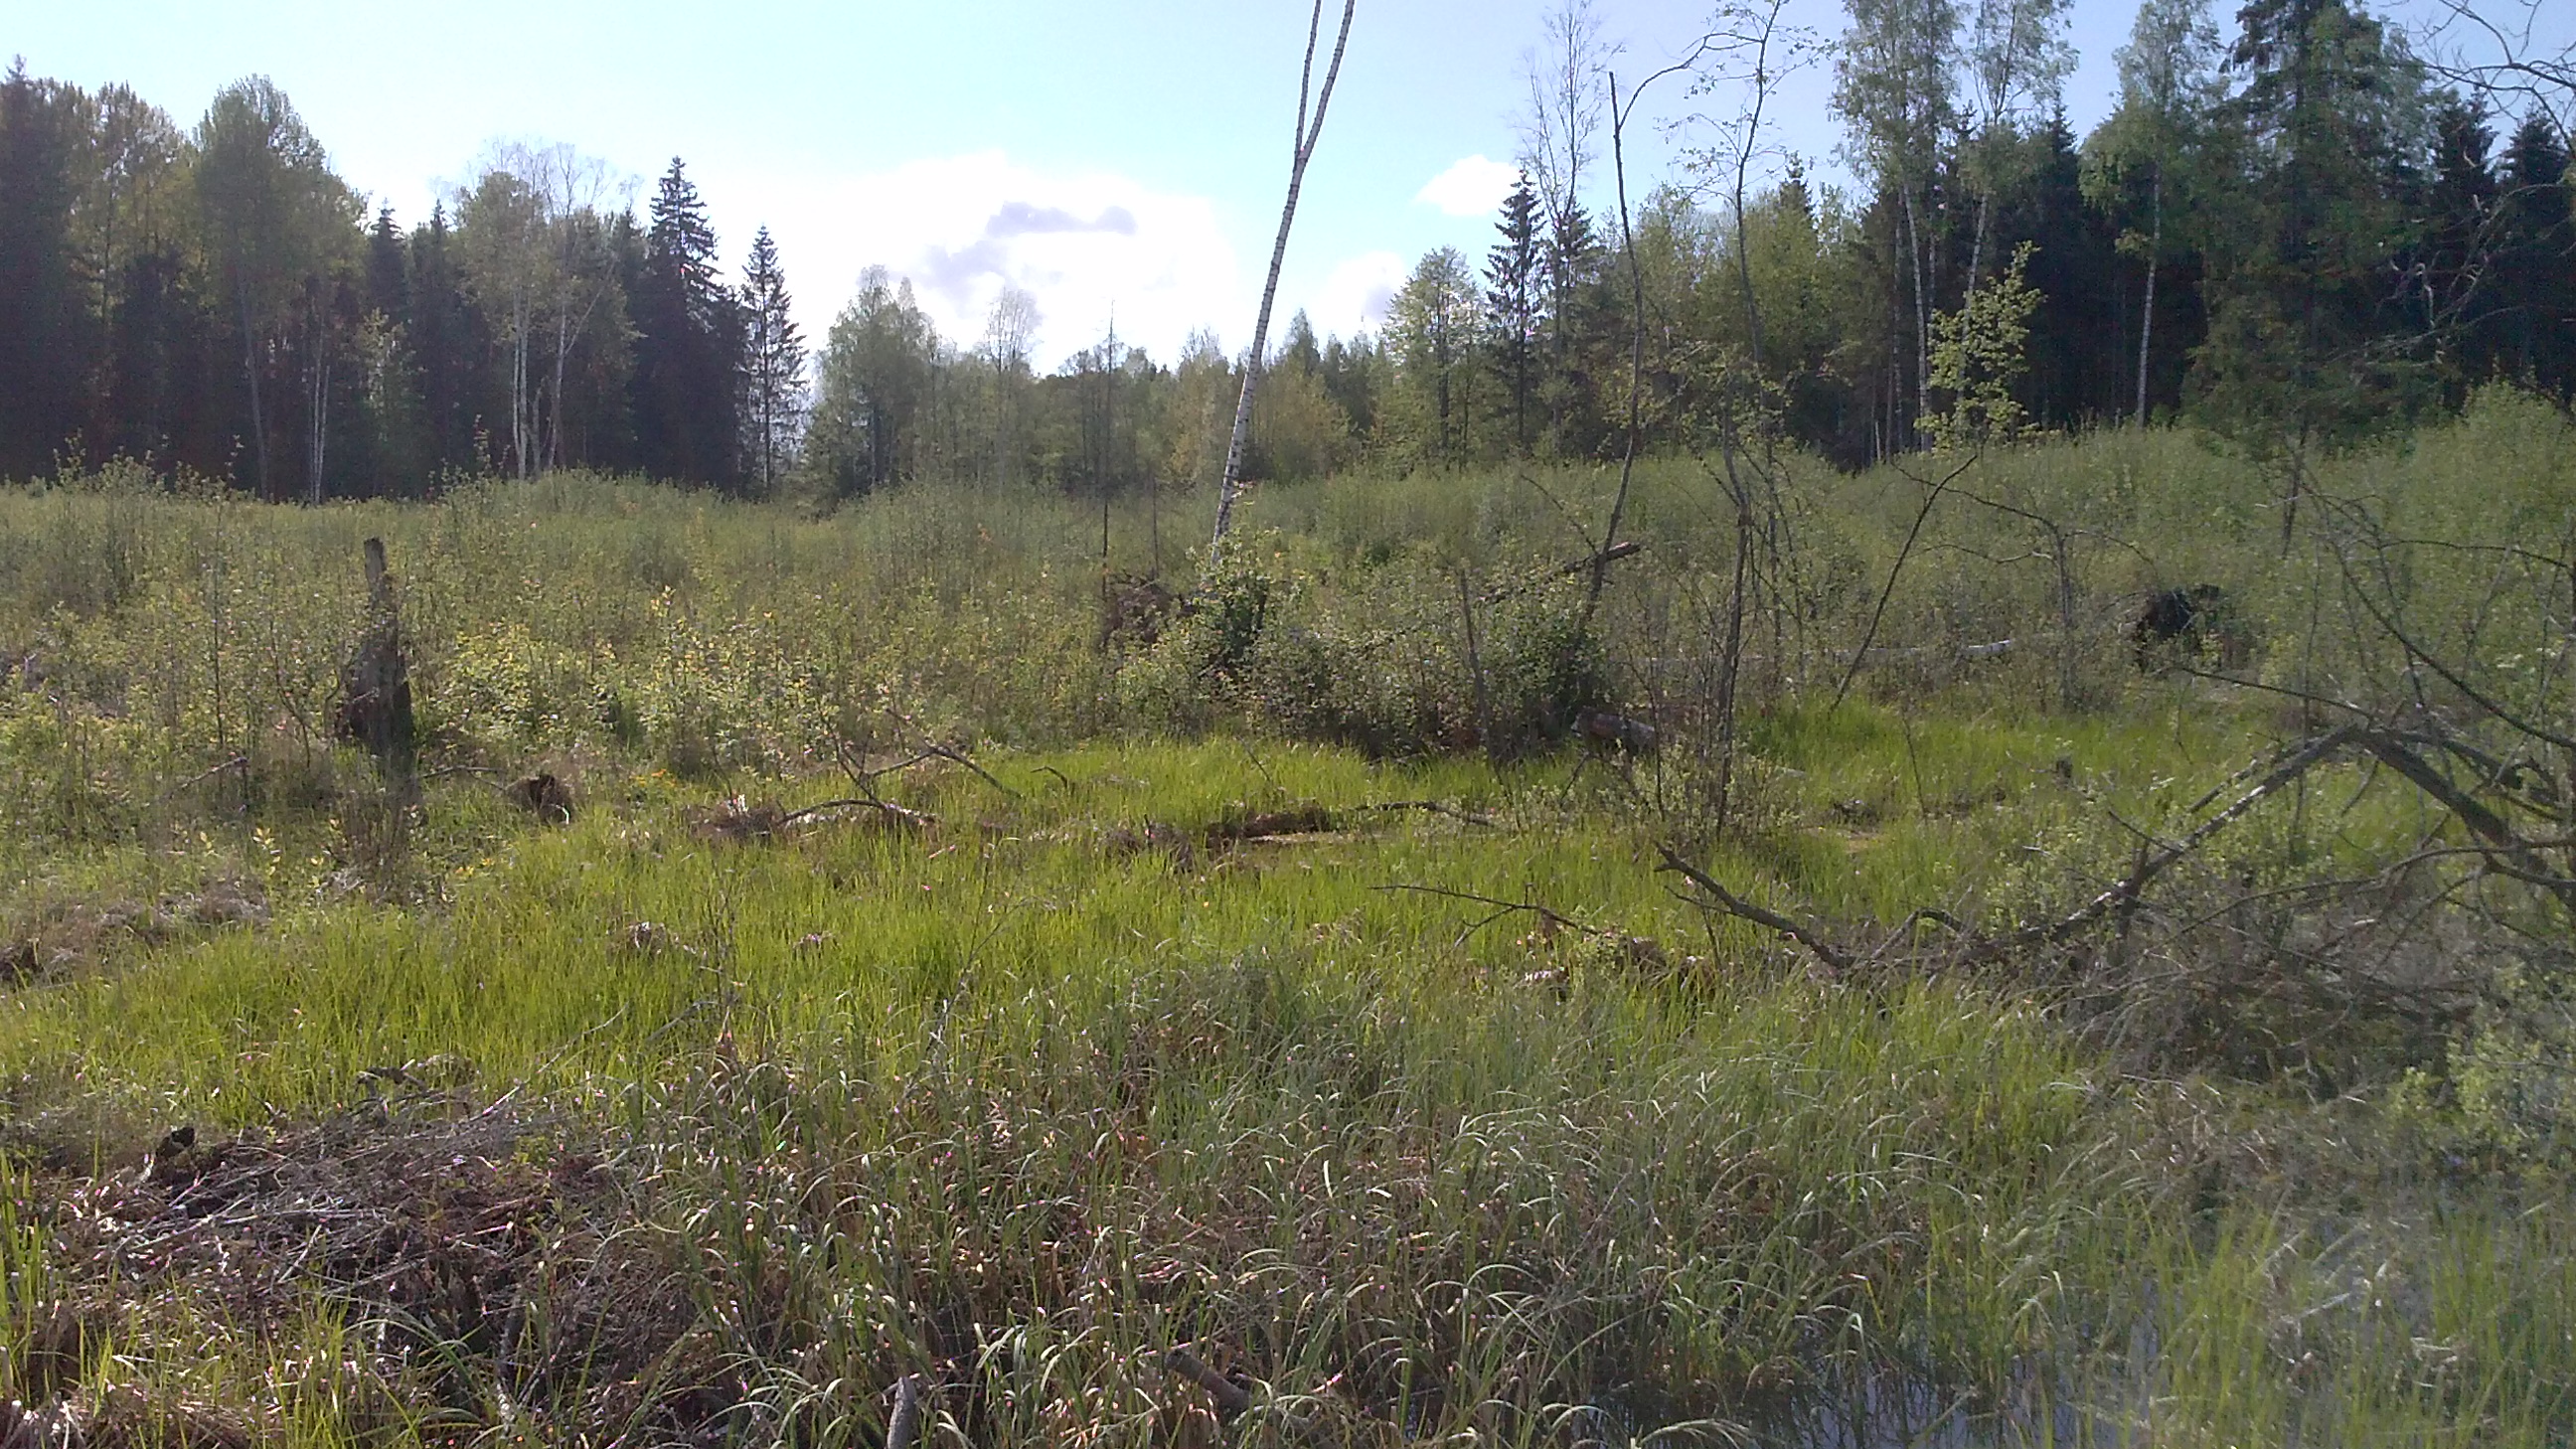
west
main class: Woodland
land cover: Broadleaved woodland
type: non-riverine alder, birch or aspen forest
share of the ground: > 75 %
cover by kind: broadleaved forest trees 100 %
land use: Forestry
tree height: > 5 m
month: May
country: LV
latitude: 56.1056
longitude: 27.6975
